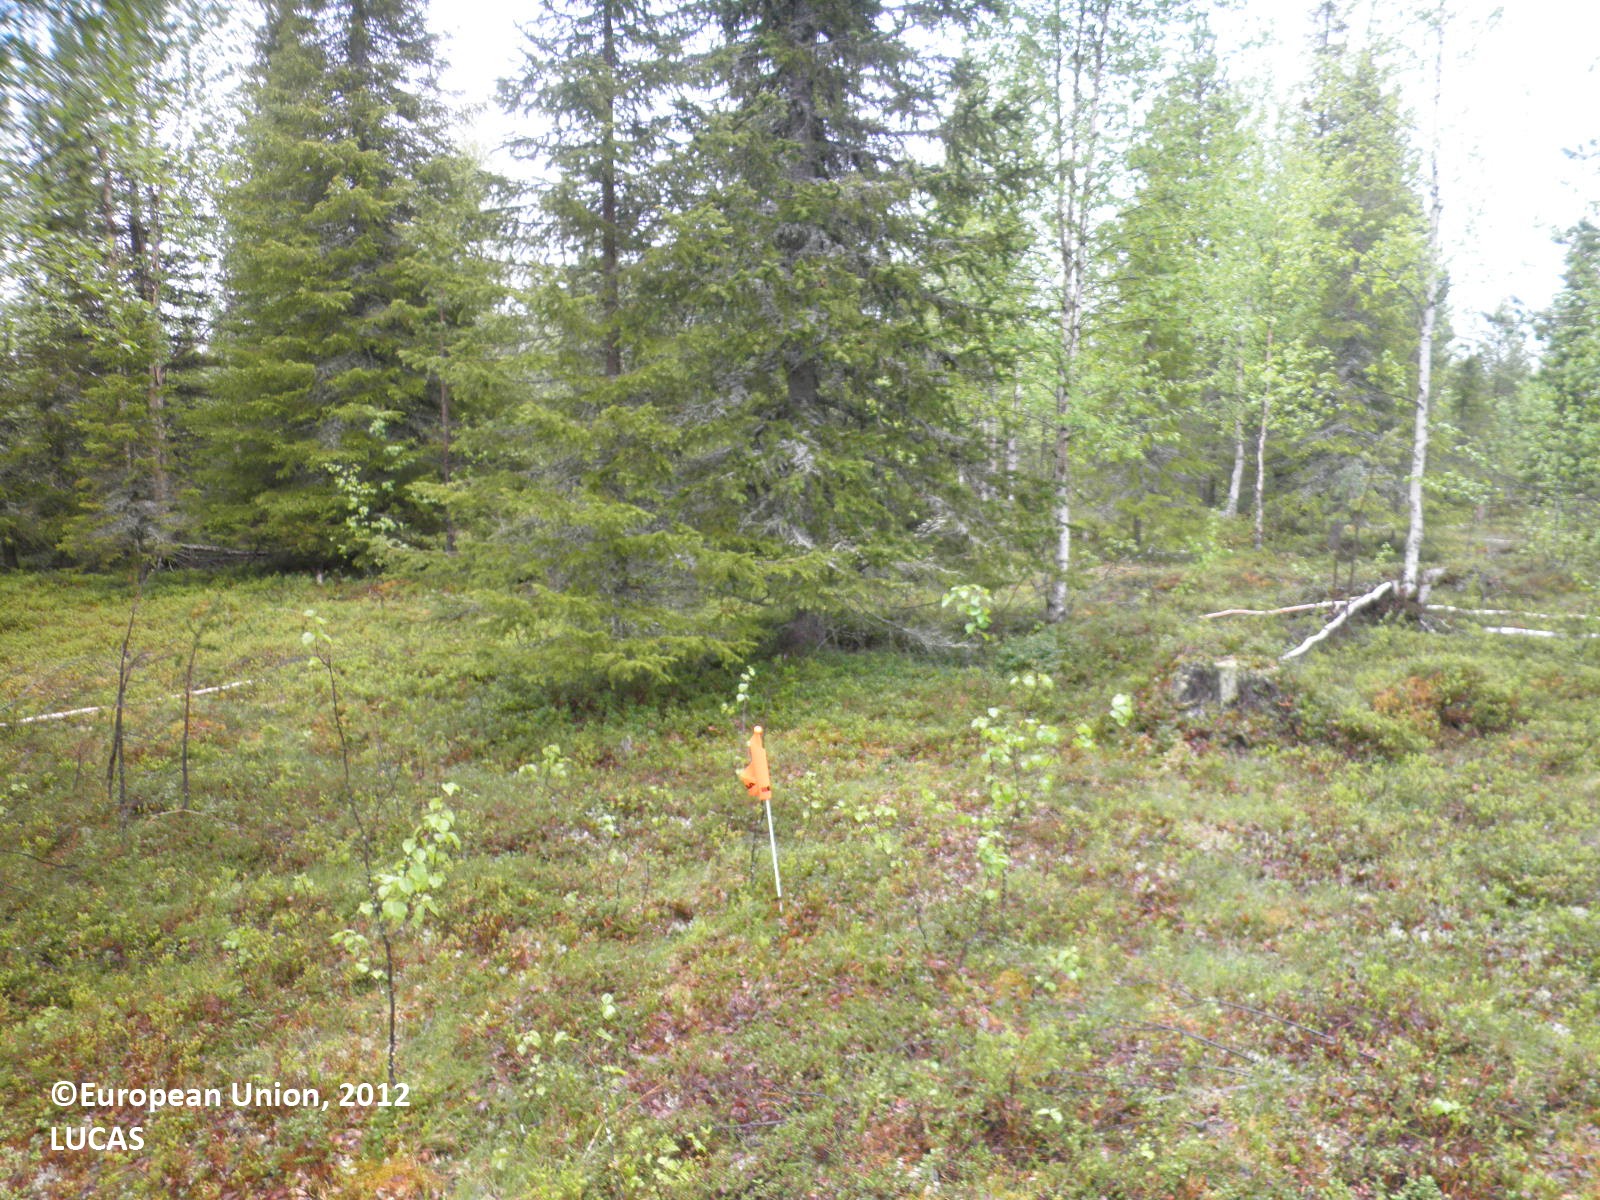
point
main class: Woodland
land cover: Spruce dominated mixed woodland
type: boreal forest
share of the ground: 50 - 75 %
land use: Forestry
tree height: > 5 m
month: June
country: FI
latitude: 67.9718
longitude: 25.6459
